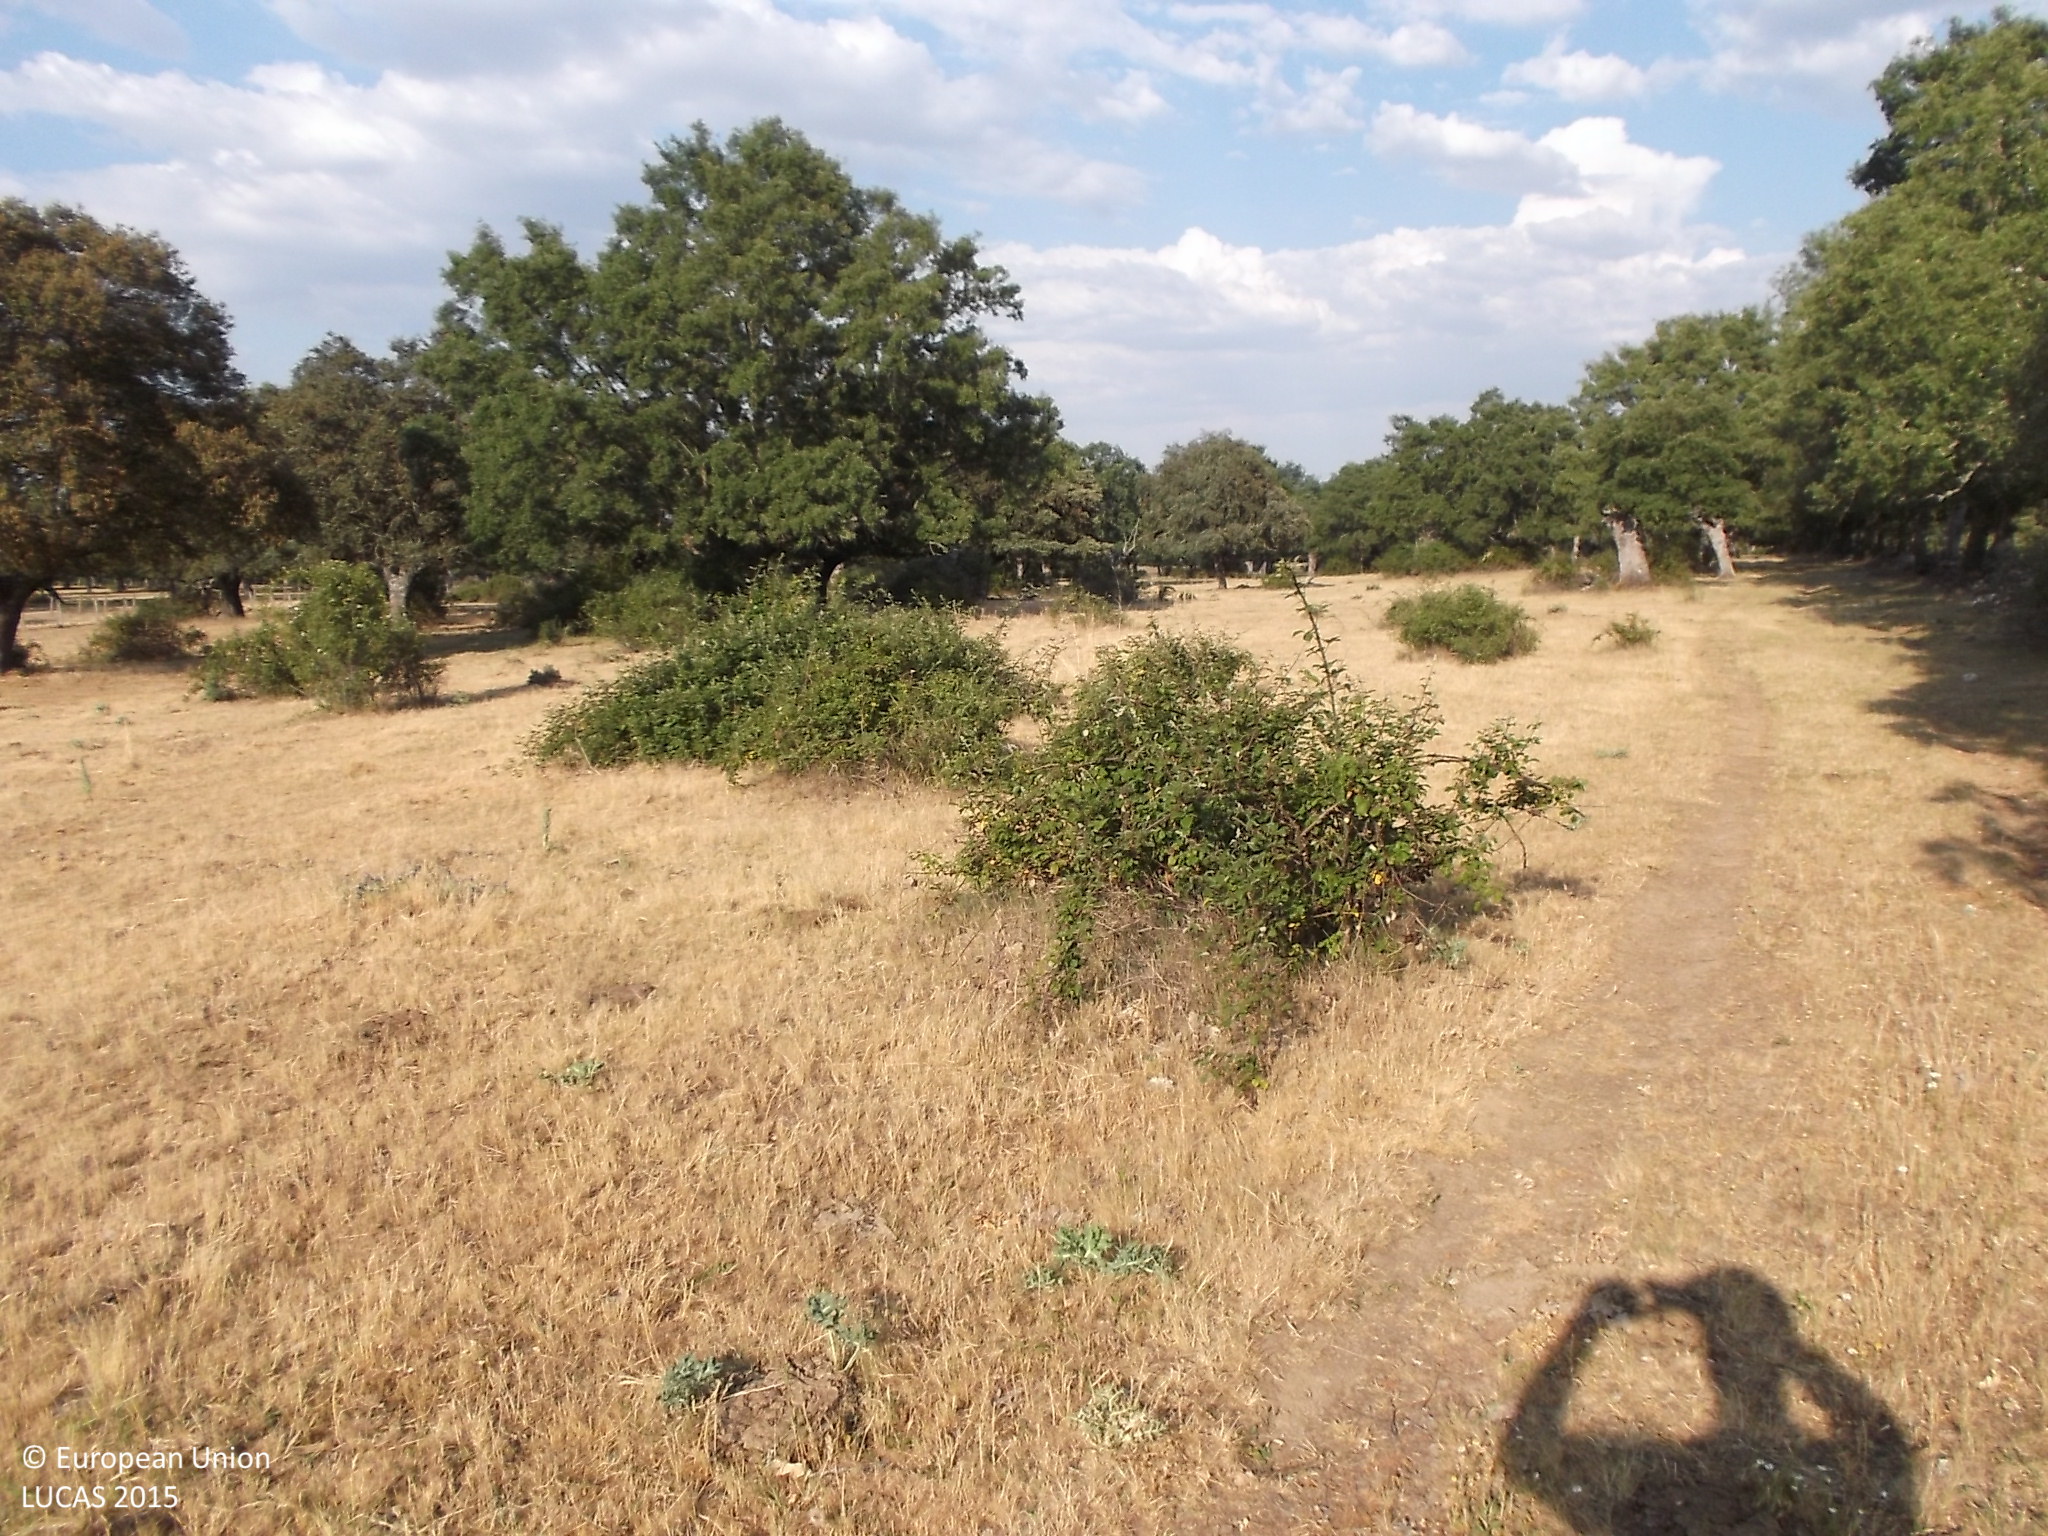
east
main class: Grassland
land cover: Grassland with sparse tree/shrub cover
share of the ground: > 75 %
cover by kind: herbaceous plants 90 %, broadleaved forest trees 5 %, shrubs 5 %
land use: Agriculture (excluding fallow land and kitchen gardens)
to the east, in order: Tracks; Grassland with sparse tree/shrub cover; Broadleaved woodland
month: June
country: ES
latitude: 40.8682
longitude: -6.3811
